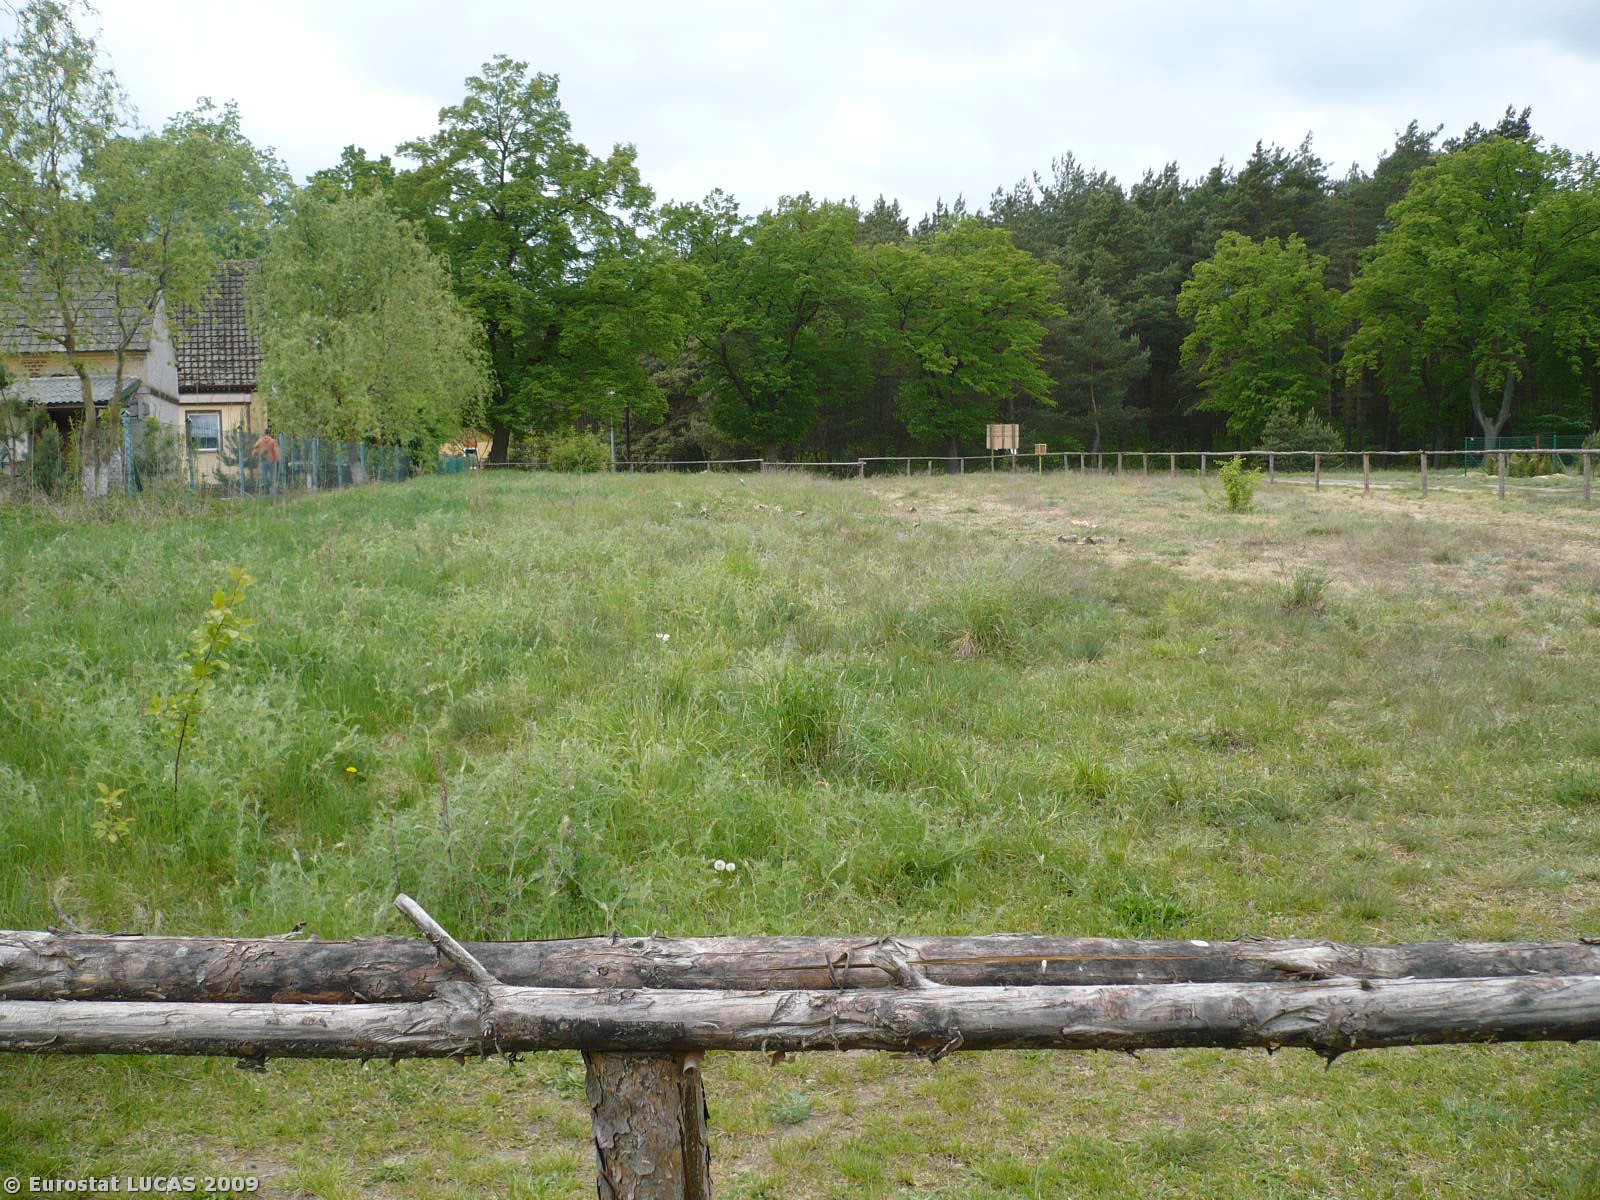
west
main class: Grassland
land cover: Spontaneously vegetated surfaces
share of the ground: > 75 %
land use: Unused
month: May
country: PL
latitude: 52.2376
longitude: 15.3779
